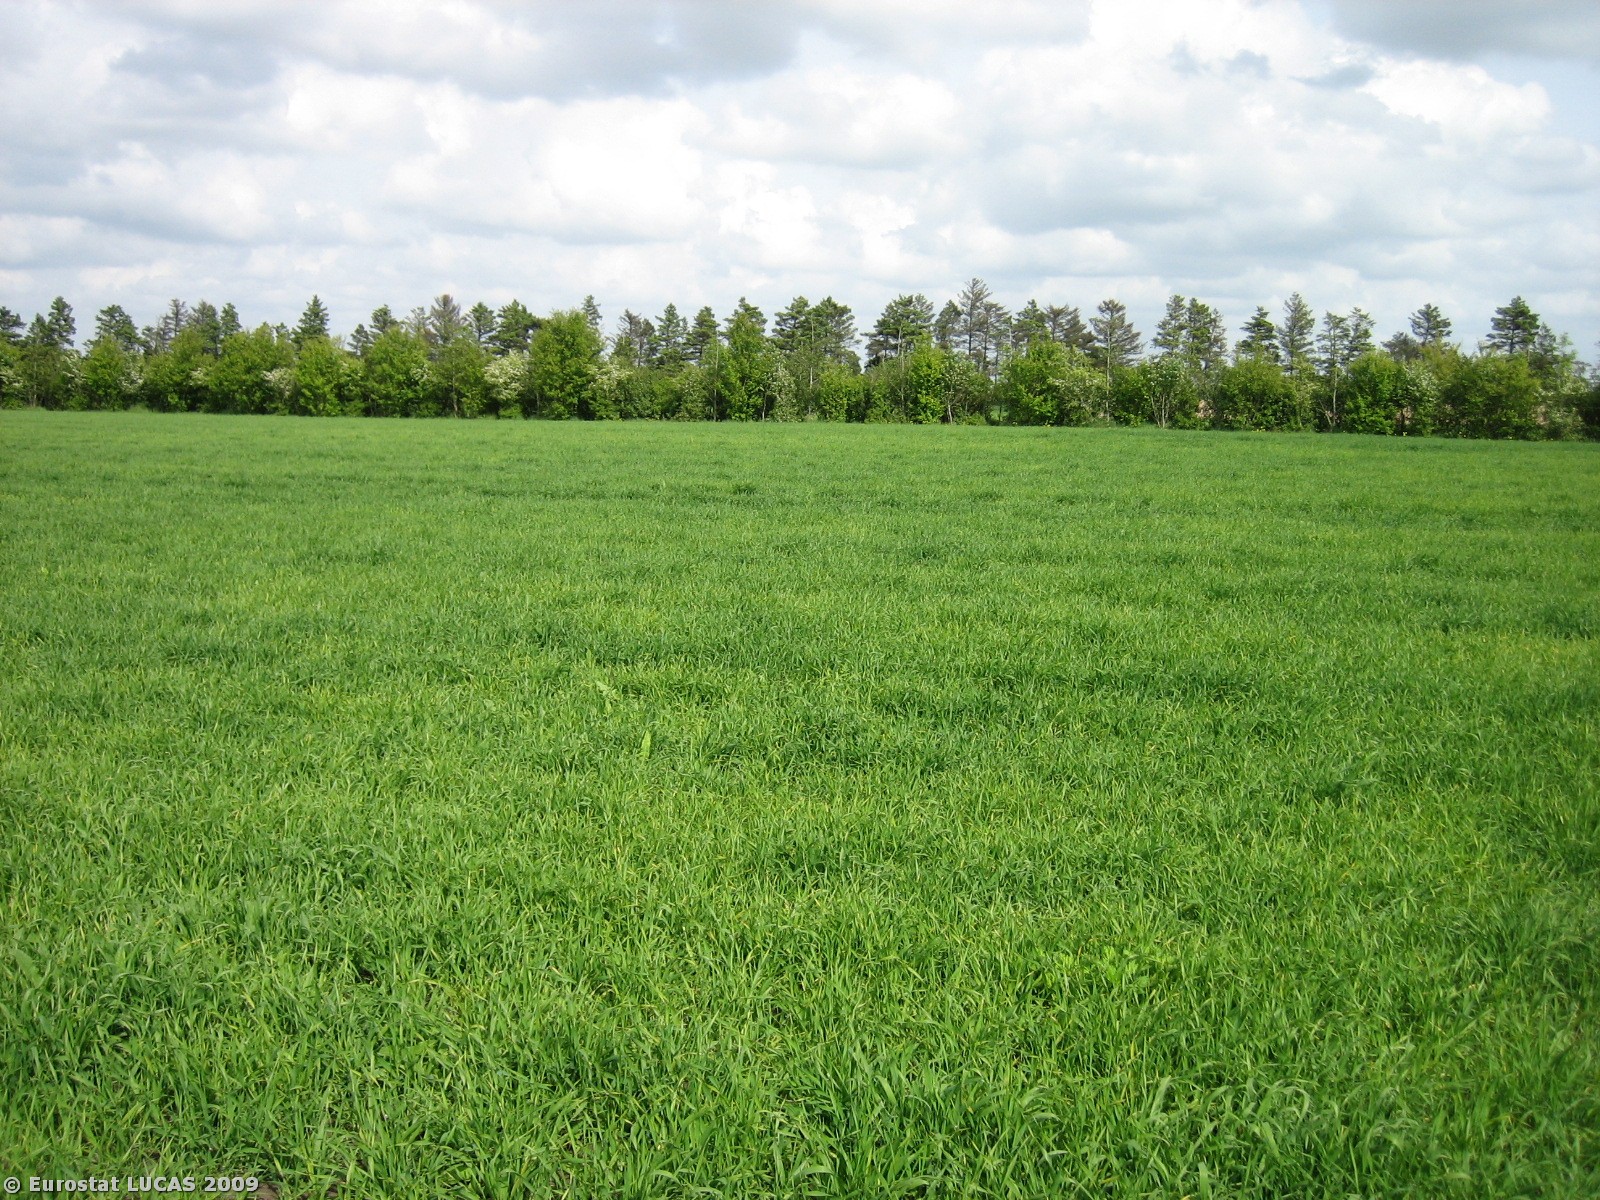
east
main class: Cropland
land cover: Barley
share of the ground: > 75 %
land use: Agriculture (excluding fallow land and kitchen gardens)
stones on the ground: 10 - 25 %
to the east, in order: Barley; Broadleaved woodland; Barley; Bare land; Grassland without tree/shrub cover; Mixed woodland; Barley
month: May
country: DK
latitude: 56.2192
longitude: 8.9208
